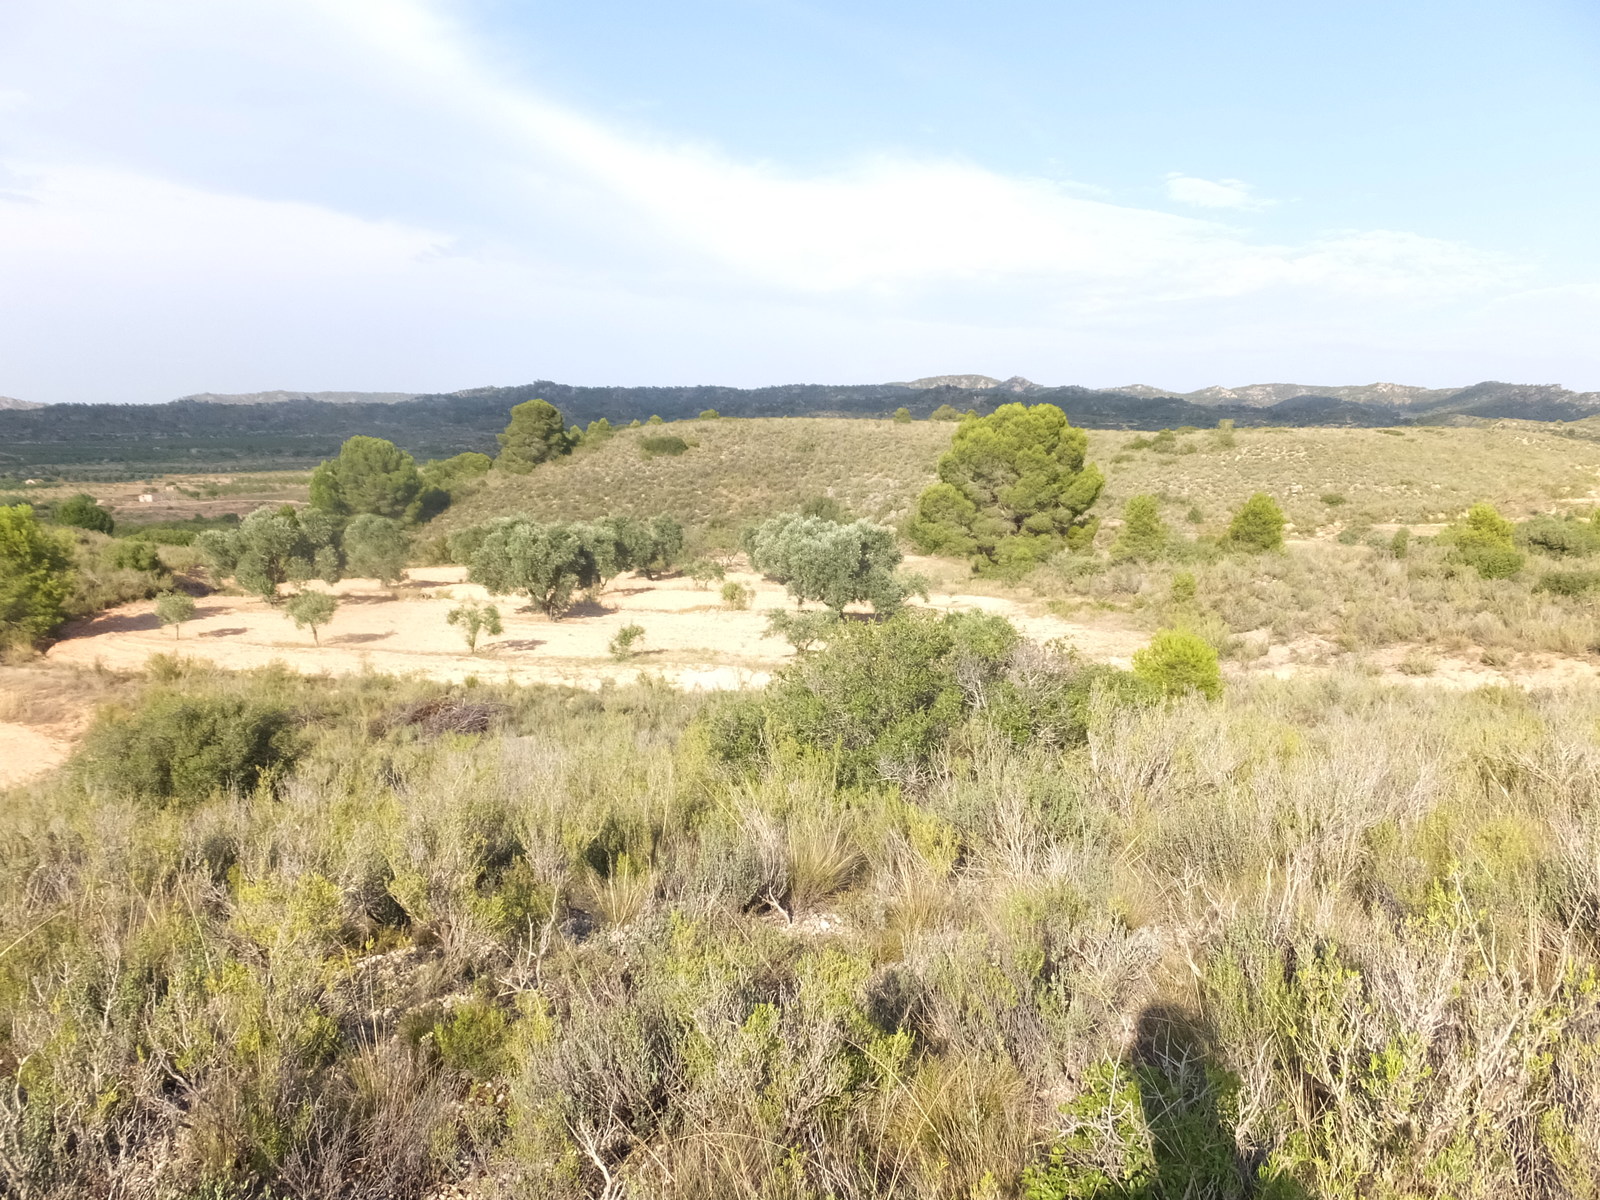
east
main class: Shrubland
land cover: Shrubland with sparse tree cover
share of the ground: > 75 %
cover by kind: shrubs 55 %, herbaceous plants 40 %, coniferous forest trees 5 %
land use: Semi-natural and natural areas not in use
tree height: < 5 m
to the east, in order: Shrubland with sparse tree cover; Tracks; Shruby margins; Olive groves; Shruby margins; Olive groves; Shrubland with sparse tree cover; Olive groves; Shrubland with sparse tree cover
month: July
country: ES
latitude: 41.1597
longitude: 0.2053
